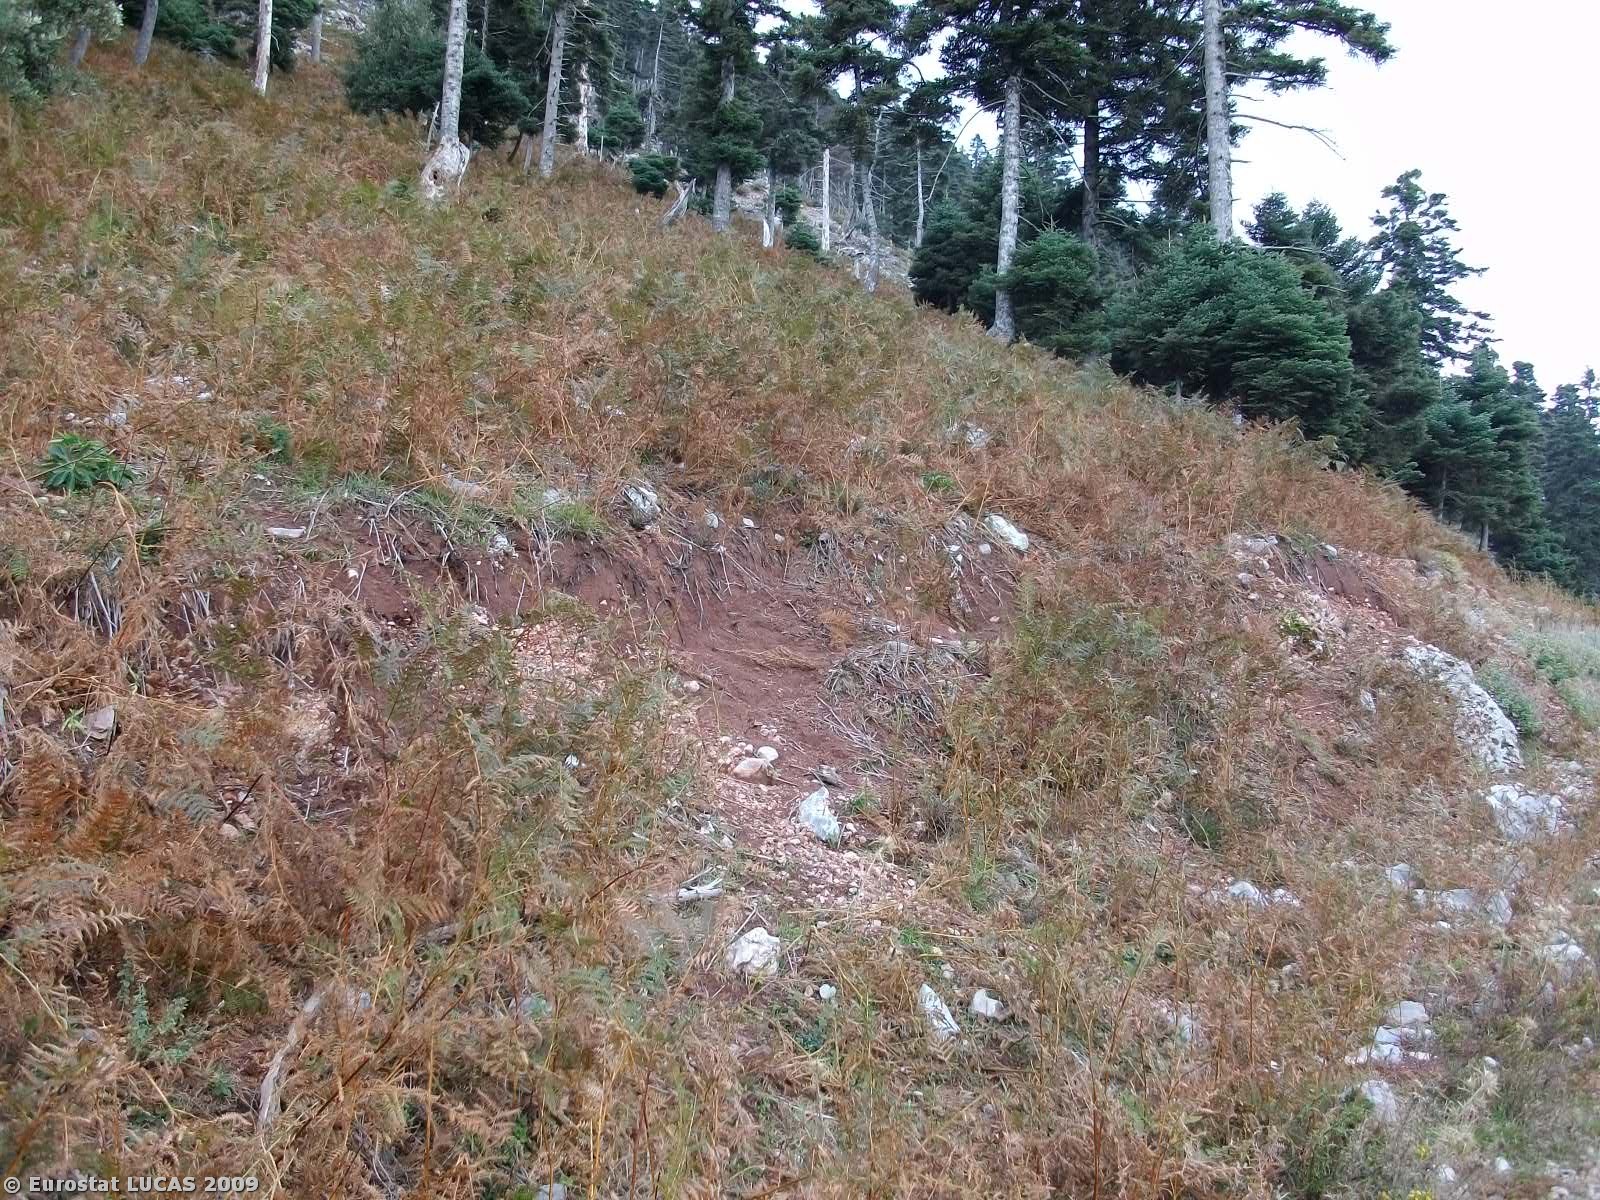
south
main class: Woodland
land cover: Coniferous woodland
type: coniferous forest of the mediterranean region
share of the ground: > 75 %
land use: Forestry
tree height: > 5 m
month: October
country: GR
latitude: 38.6527
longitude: 24.0007
